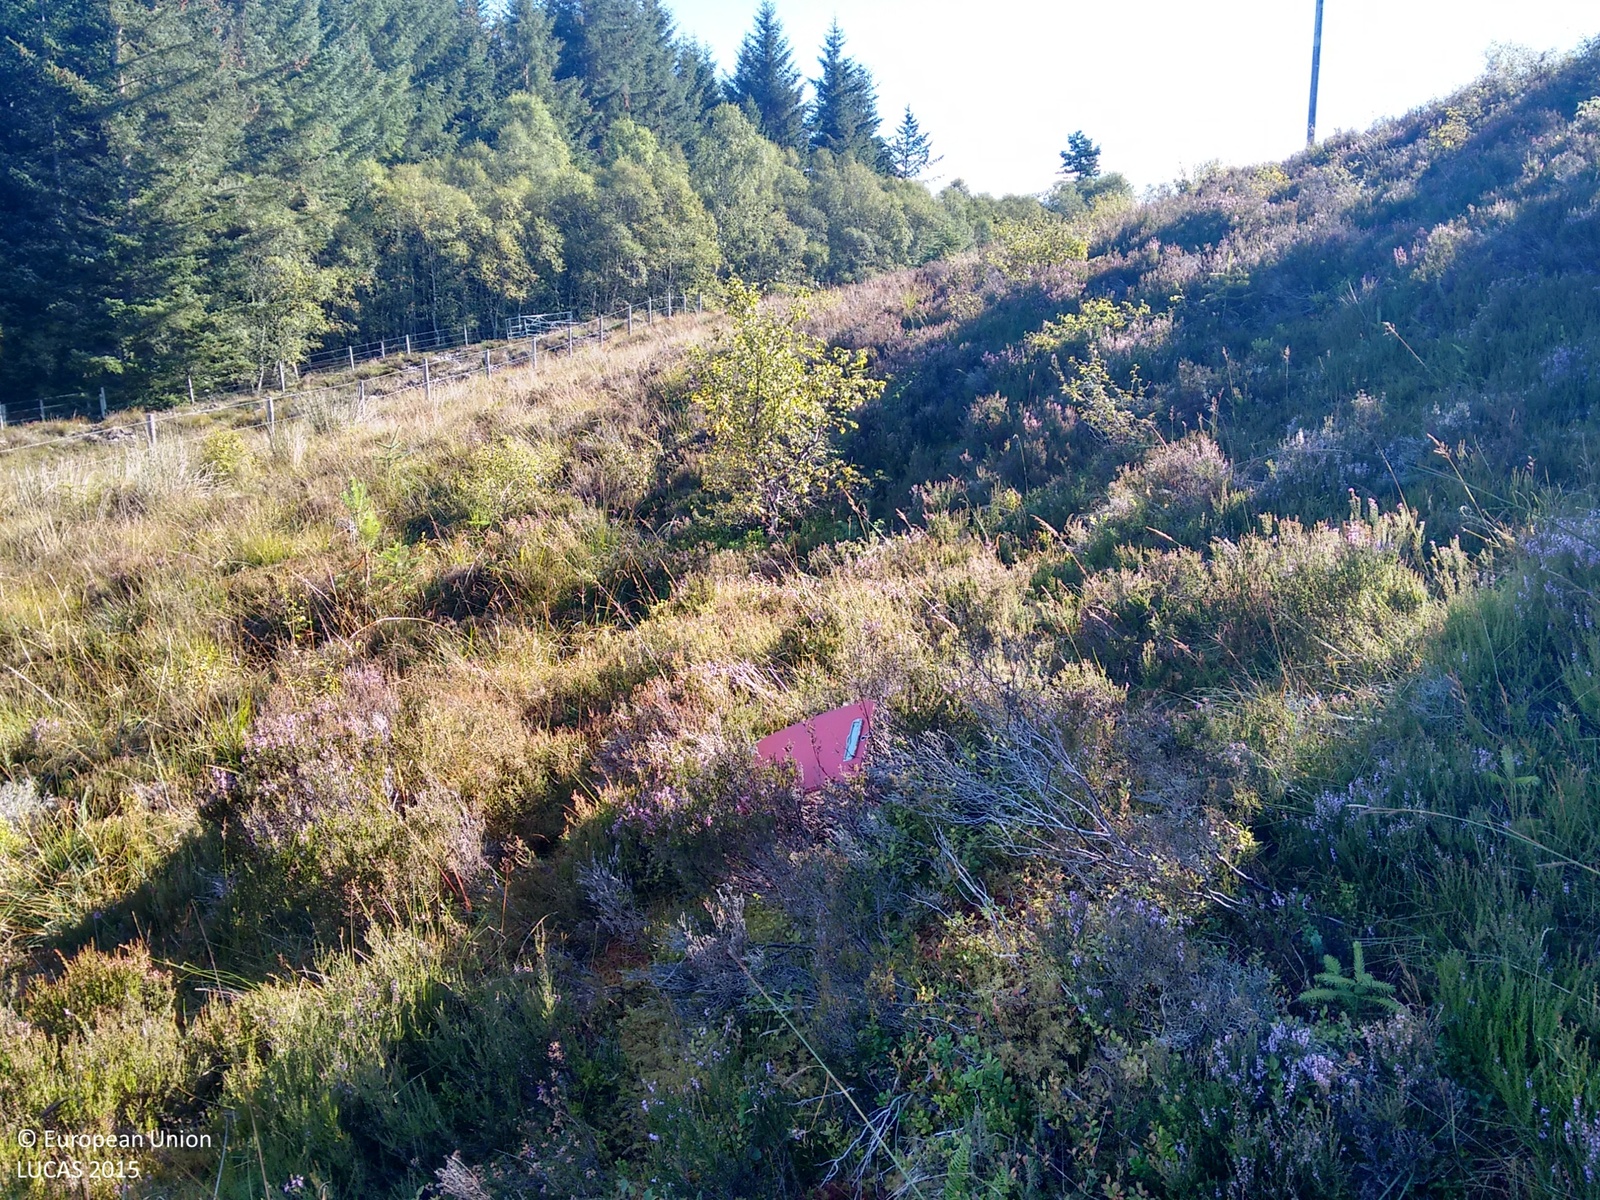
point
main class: Shrubland
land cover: Shrubland with sparse tree cover
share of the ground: > 75 %
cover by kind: shrubs 70 %, lichens and mosses 15 %, herbaceous plants 10 %, coniferous forest trees 5 %
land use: Forestry
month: September
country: GB
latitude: 57.7196
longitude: -4.3394
